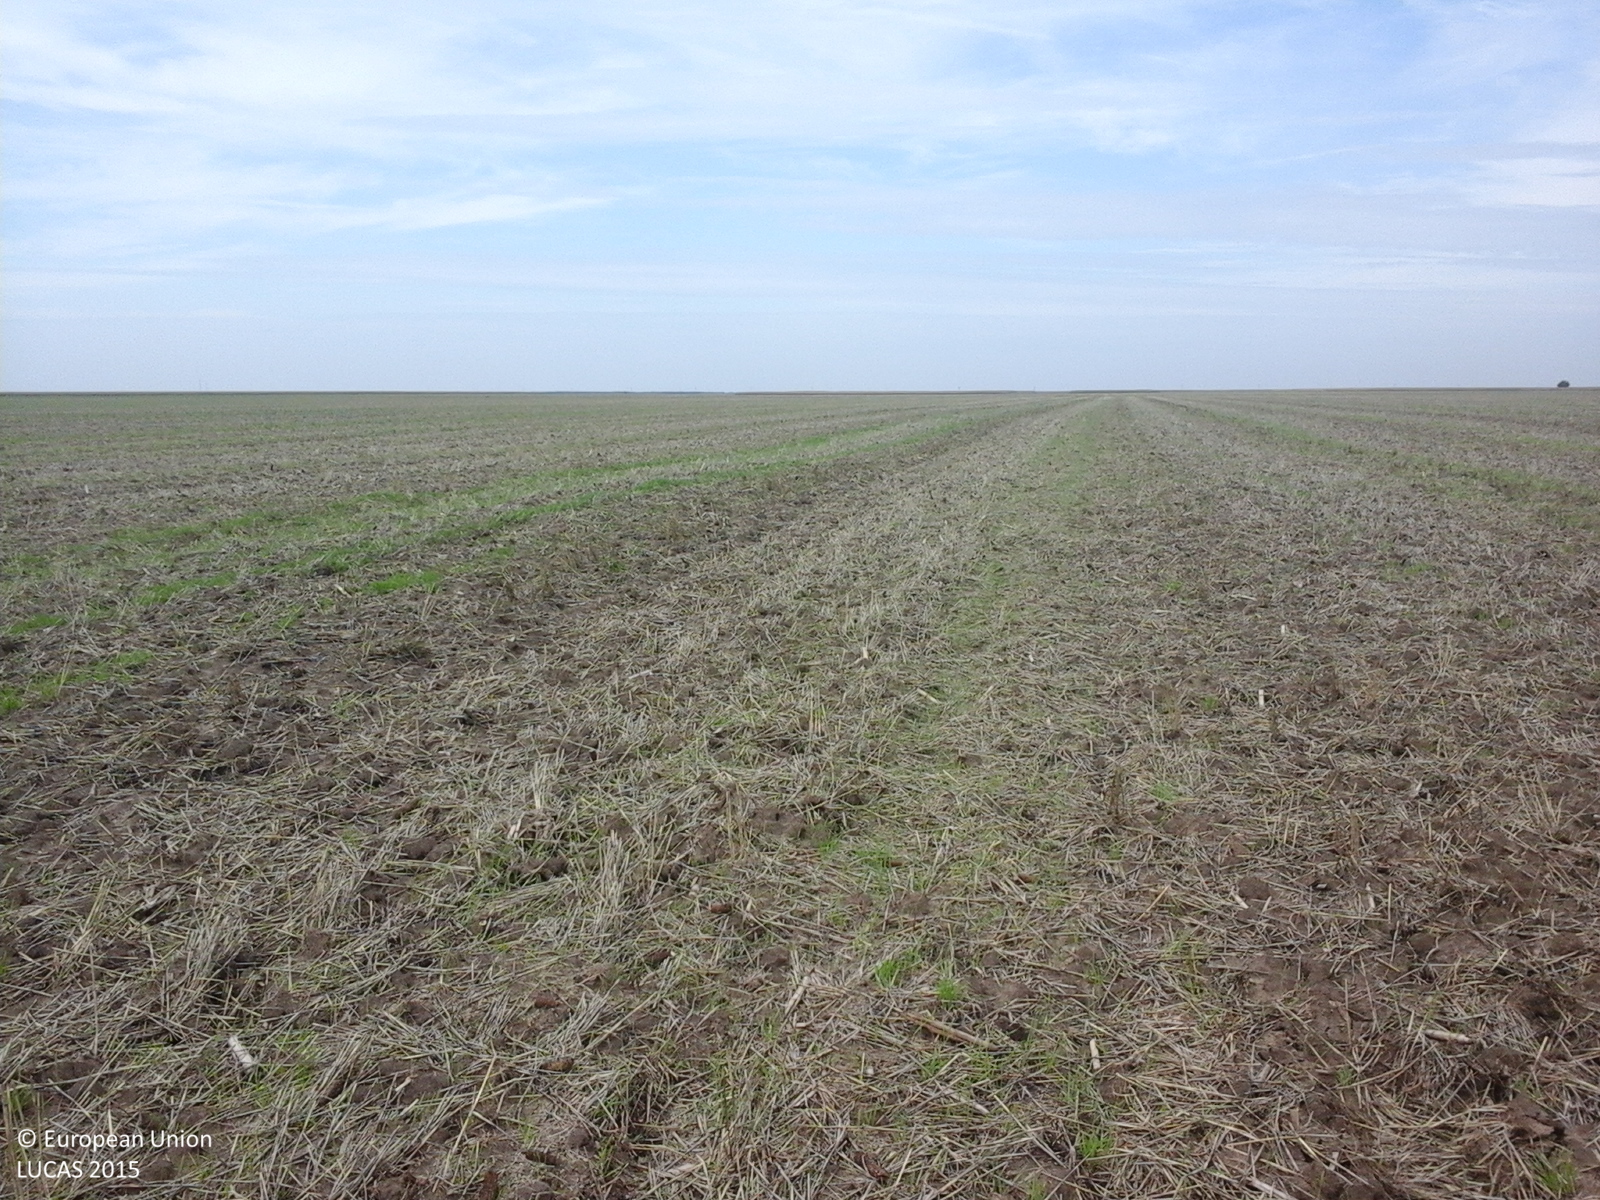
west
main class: Cropland
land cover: Common wheat
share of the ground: 25 - 50 %
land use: Agriculture (excluding fallow land and kitchen gardens)
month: August
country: RO
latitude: 46.2870
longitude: 21.5503
